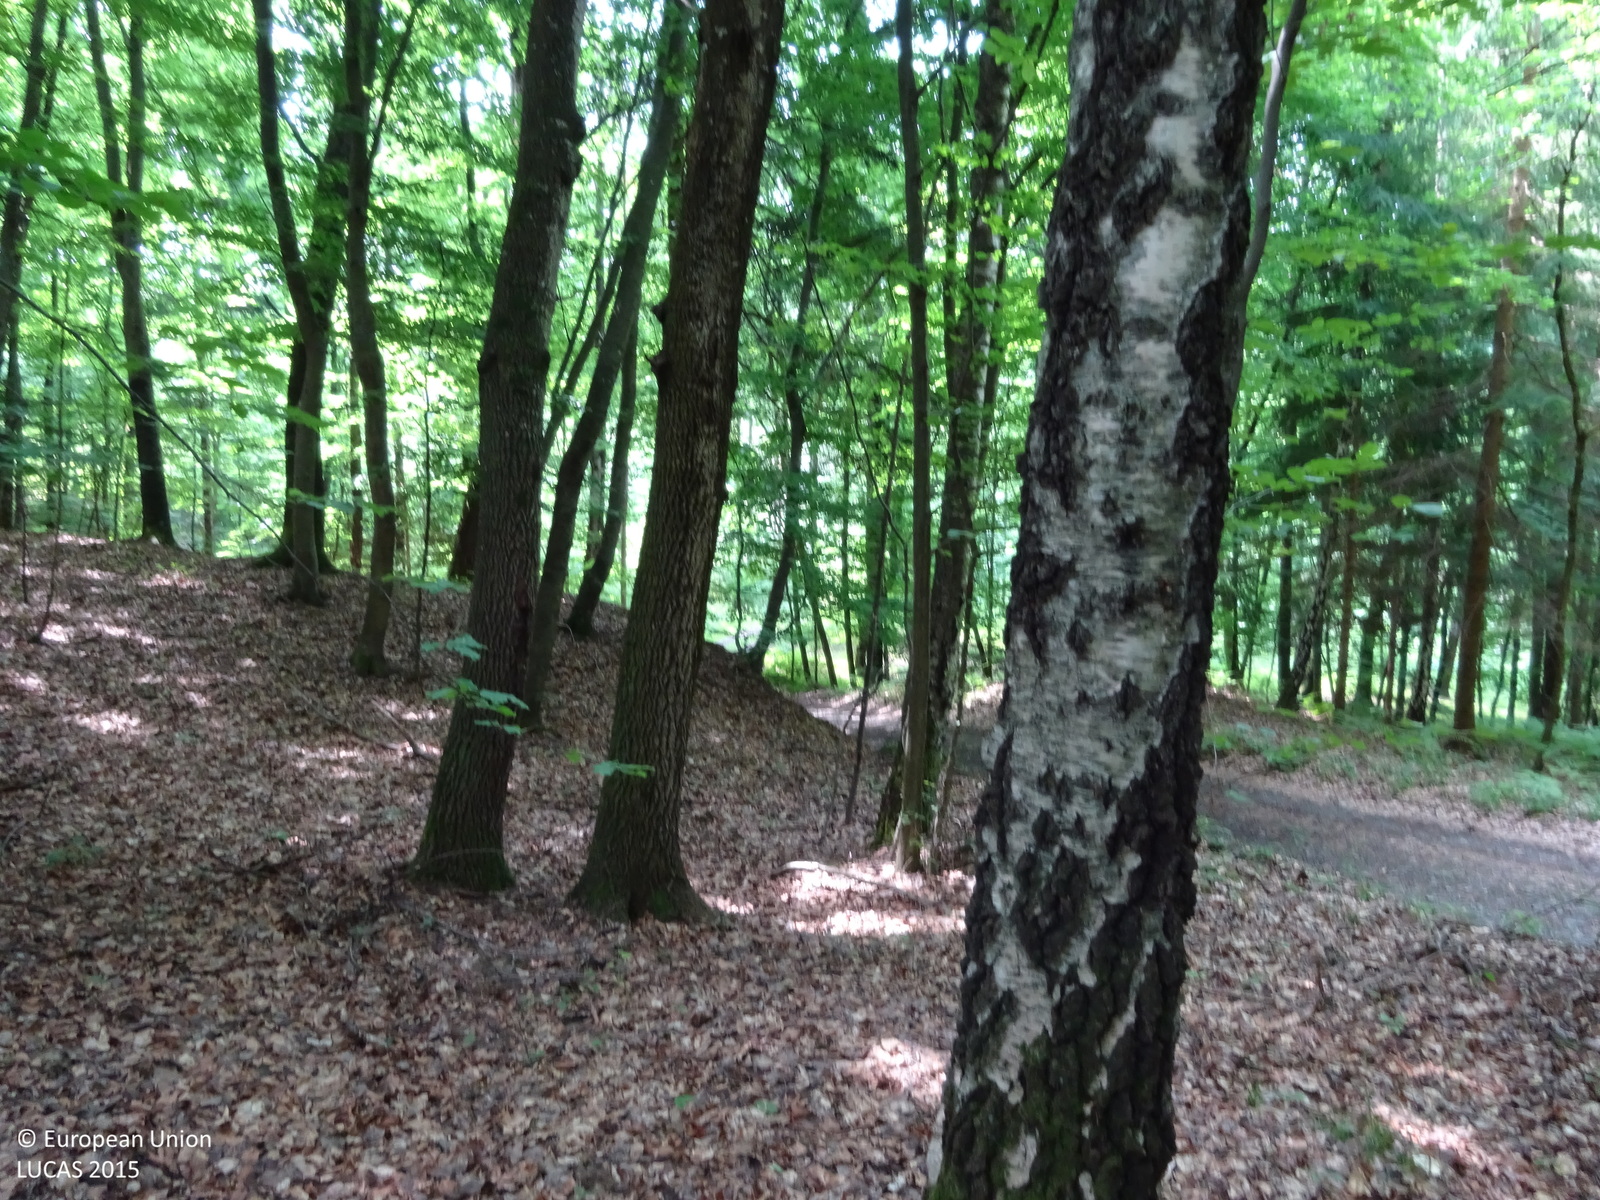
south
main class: Woodland
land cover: Pine dominated mixed woodland
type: hemiboreal forest and nemoral coniferous forest and mixed broadleaved-coniferous forest
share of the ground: > 75 %
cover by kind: broadleaved forest trees 75 %, coniferous forest trees 25 %
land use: Forestry
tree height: > 5 m
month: June
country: AT
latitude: 46.8541
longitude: 15.9418
